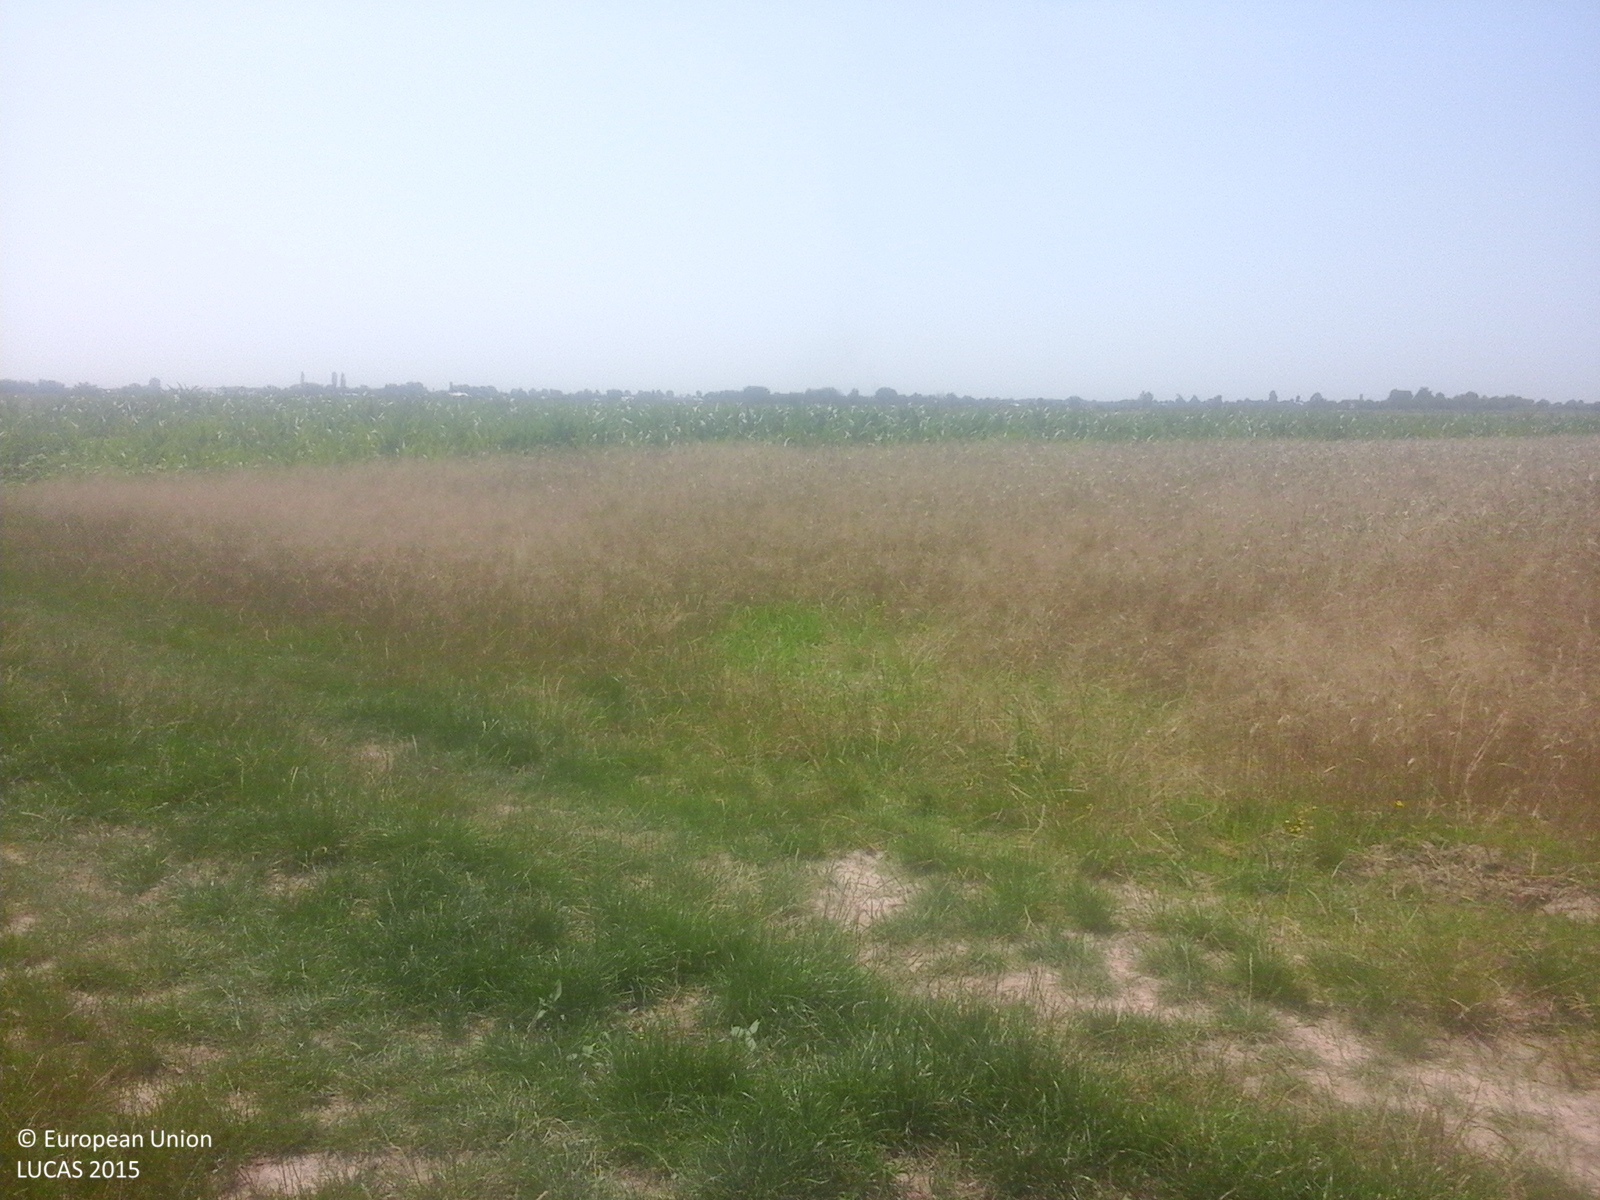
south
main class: Cropland
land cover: Maize
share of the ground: > 75 %
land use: Agriculture (excluding fallow land and kitchen gardens)
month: July
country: RO
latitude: 44.7194
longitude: 24.9923
